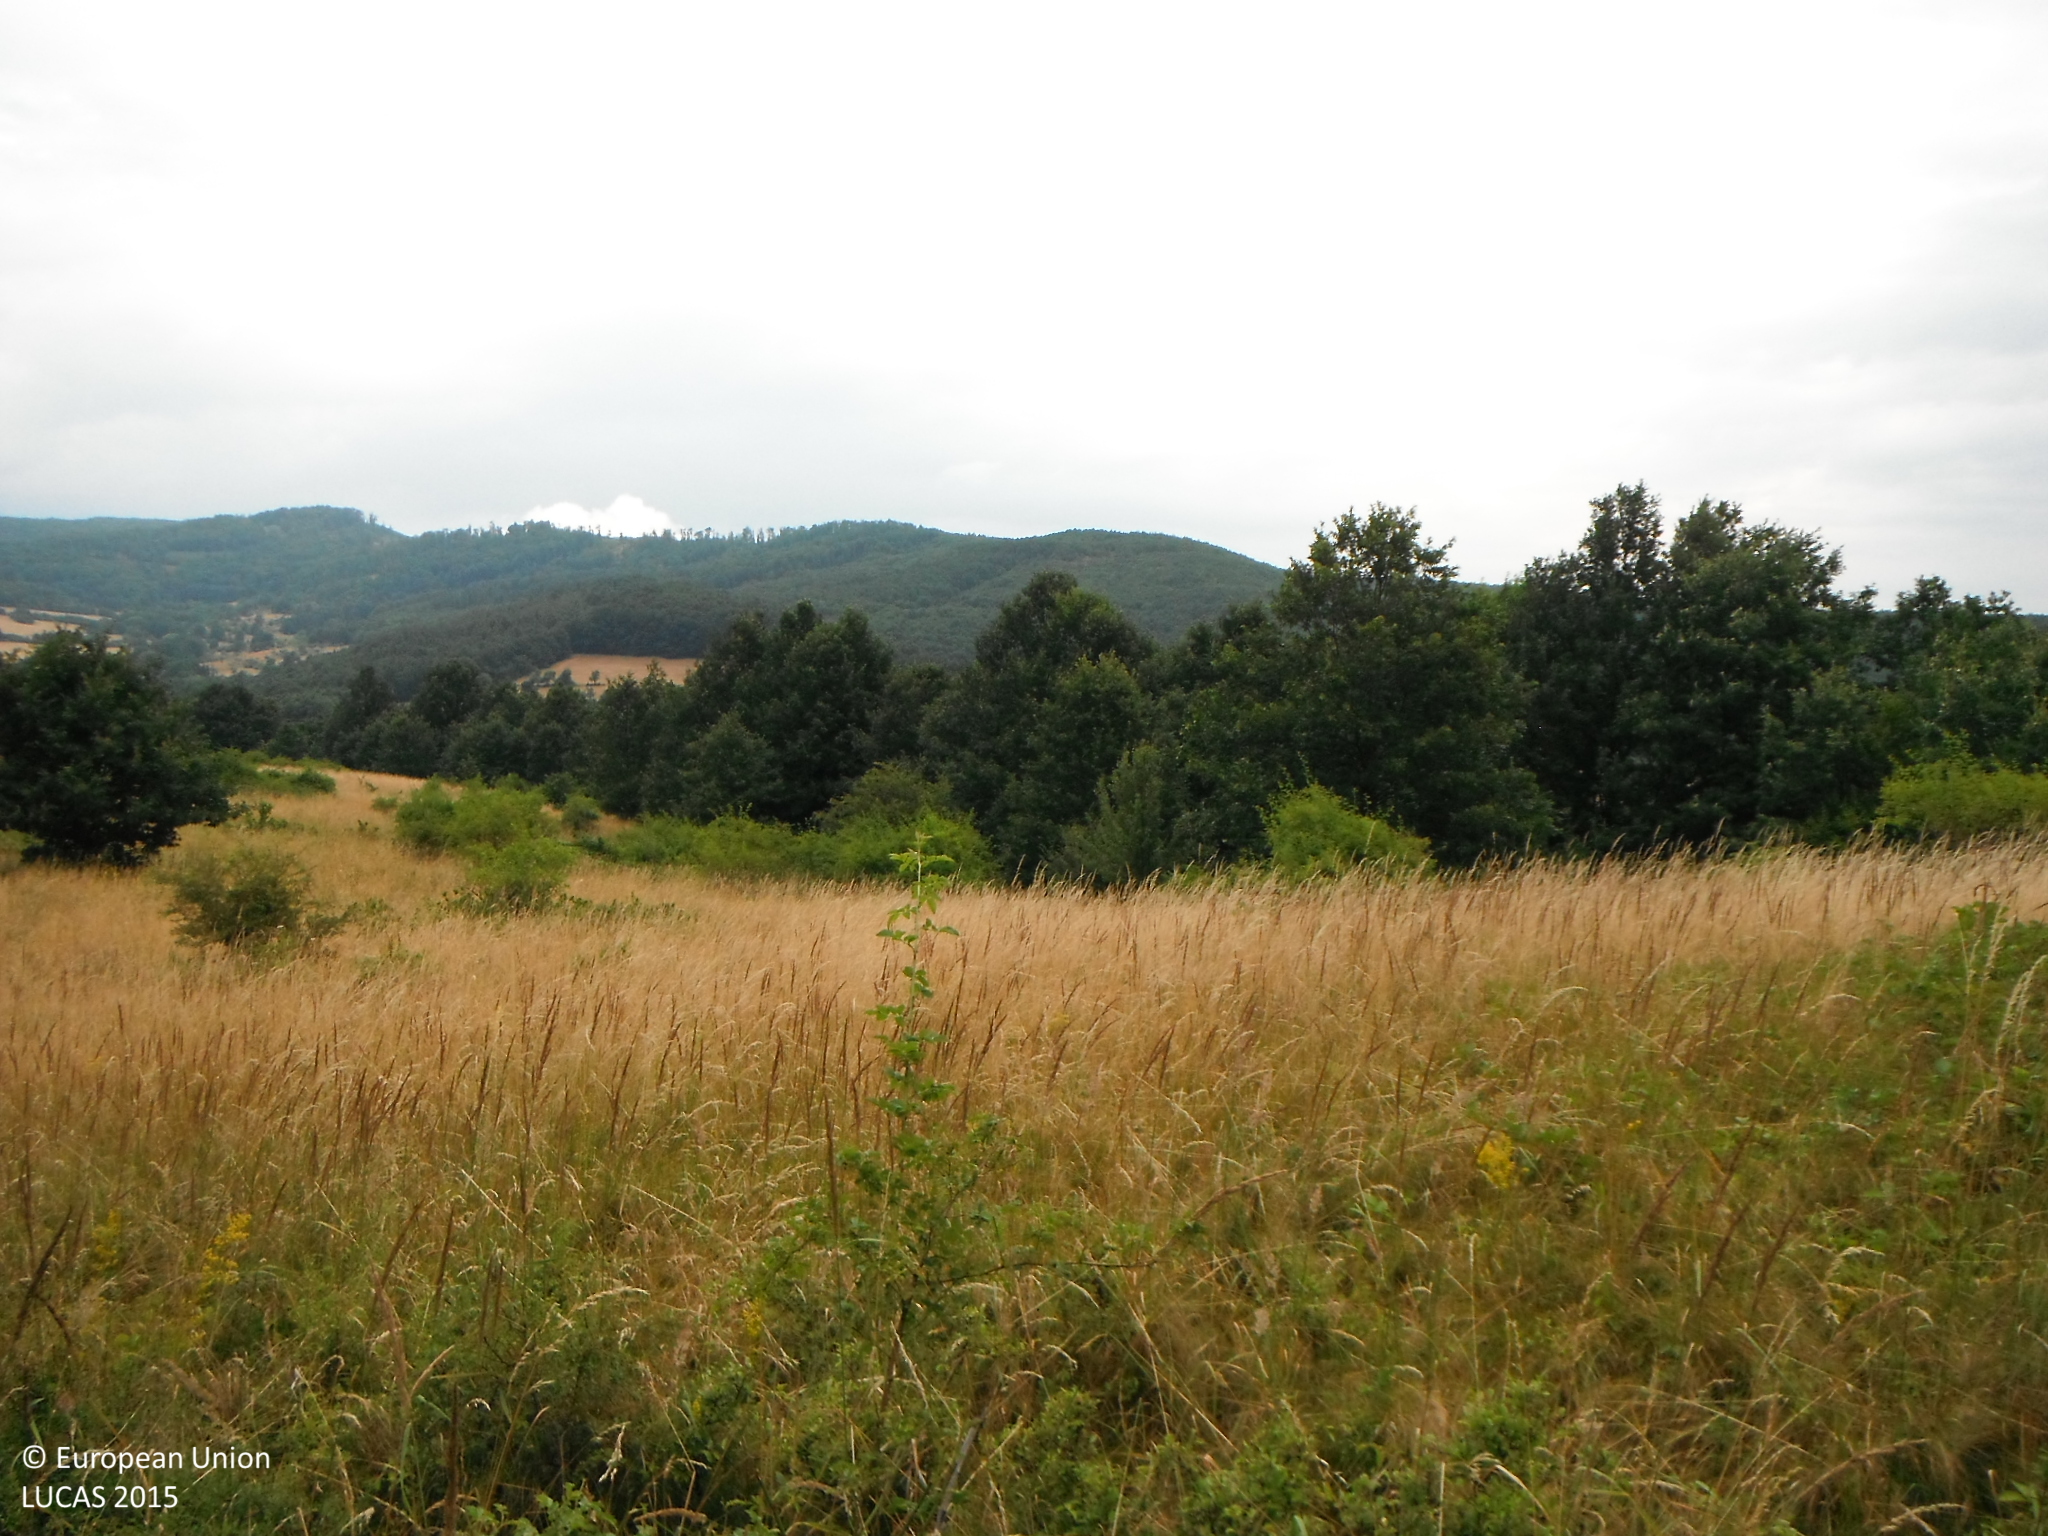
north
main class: Shrubland
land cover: Shrubland with sparse tree cover
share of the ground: > 75 %
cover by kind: shrubs 80 %, herbaceous plants 15 %, broadleaved forest trees 5 %
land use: Semi-natural and natural areas not in use
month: July
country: SK
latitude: 48.3799
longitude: 18.9990
